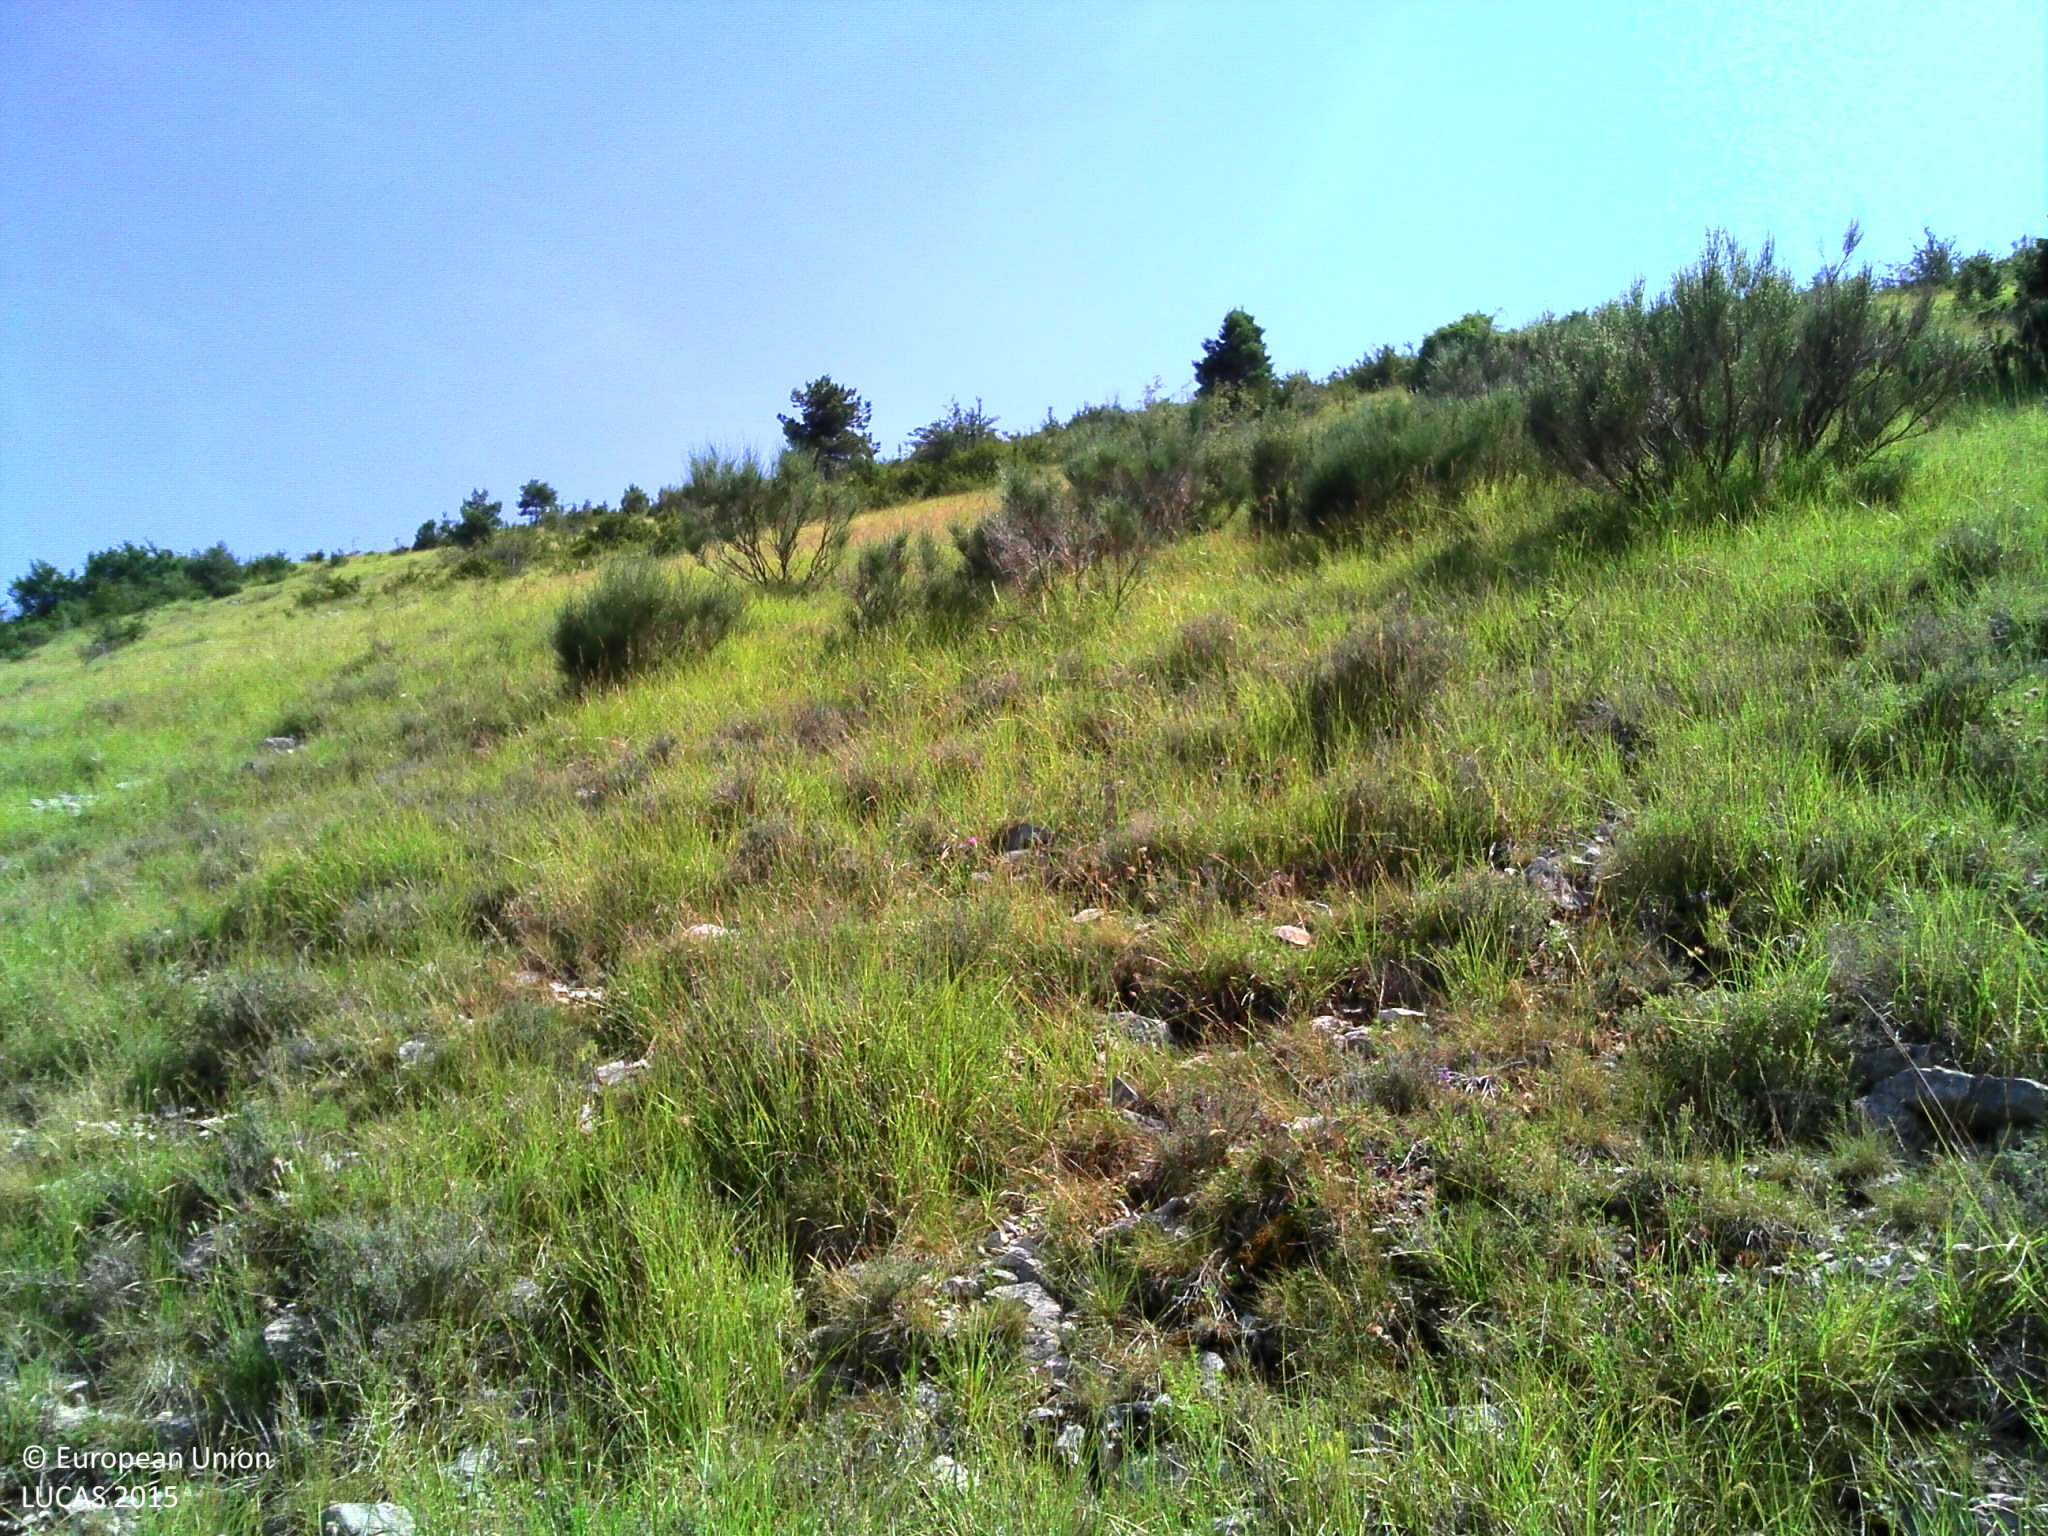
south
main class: Grassland
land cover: Grassland with sparse tree/shrub cover
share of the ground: > 75 %
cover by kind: herbaceous plants 75 %, shrubs 10 %, coniferous forest trees 5 %, consolidated bare surface 5 %, unconsolidated bare surface 5 %
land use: Agriculture (excluding fallow land and kitchen gardens)
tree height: < 5 m
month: June
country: FR
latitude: 43.8049
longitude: 7.1106
